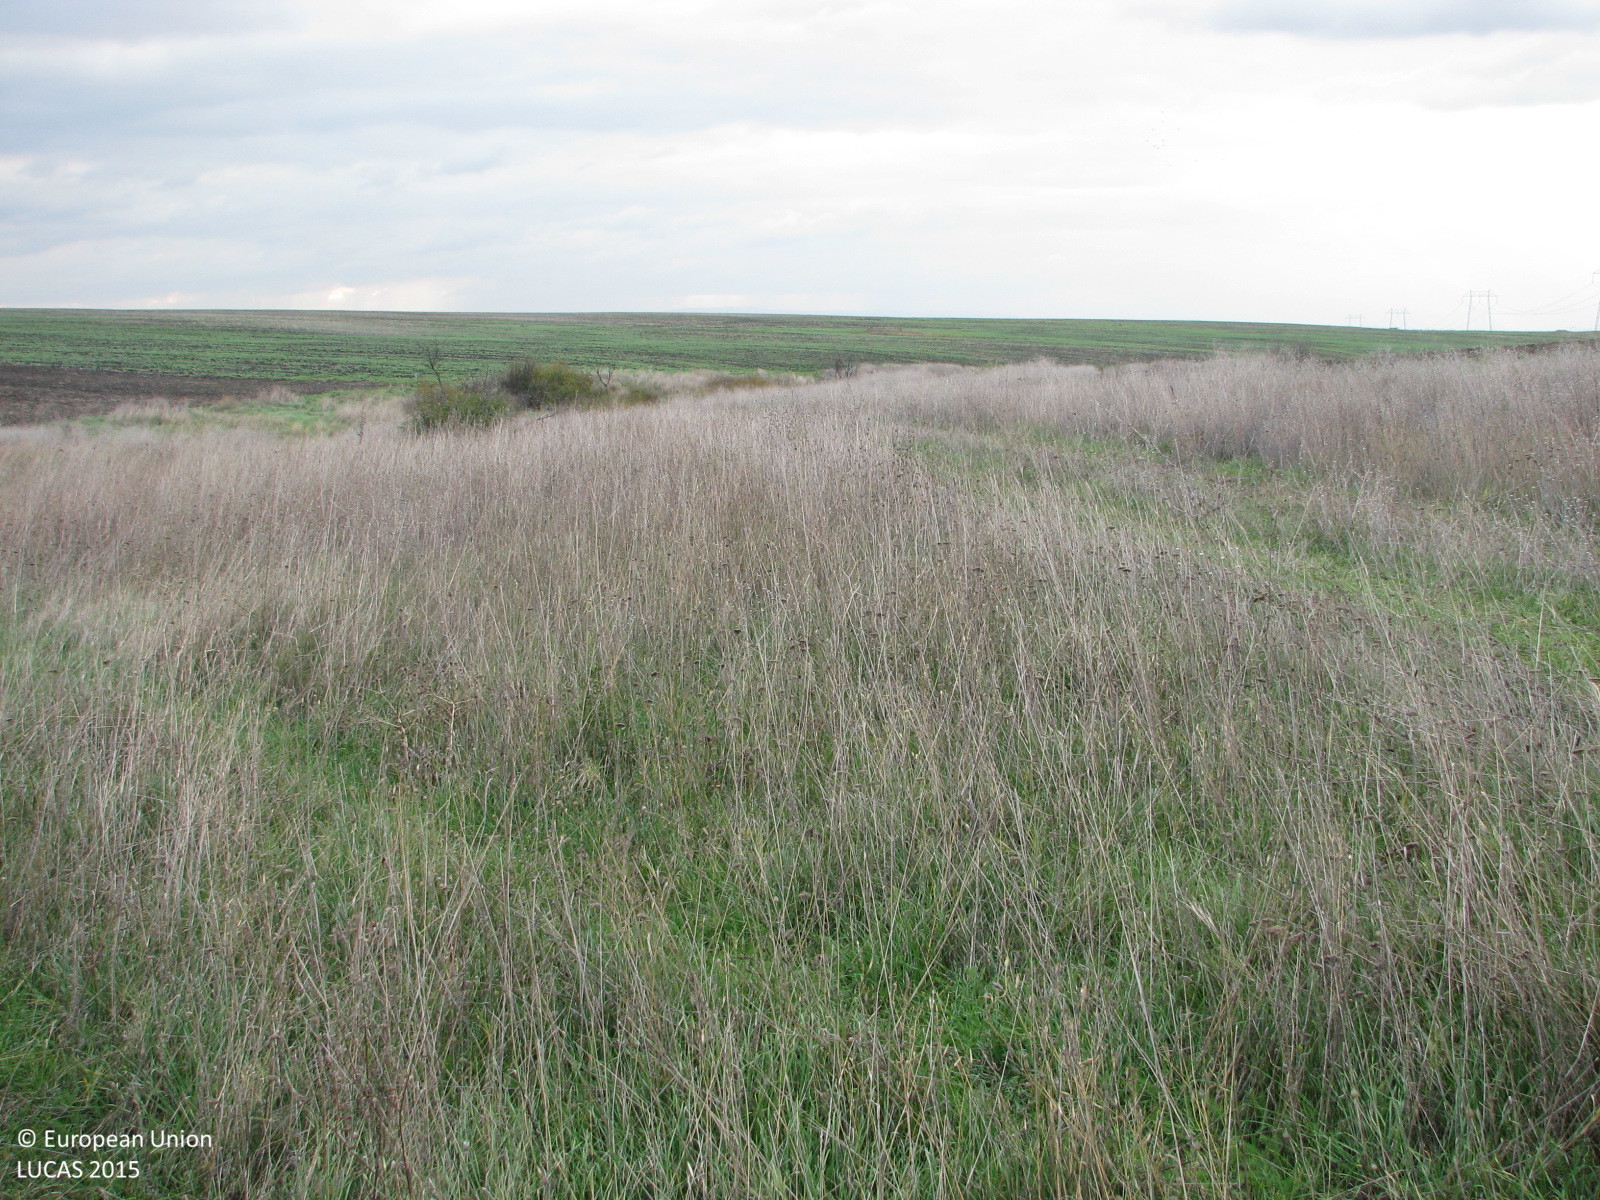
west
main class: Grassland
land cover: Grassland with sparse tree/shrub cover
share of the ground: > 75 %
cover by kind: herbaceous plants 90 %, broadleaved forest trees 5 %, shrubs 5 %
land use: Semi-natural and natural areas not in use
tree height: < 5 m
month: October
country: BG
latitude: 42.2304
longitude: 26.7056
